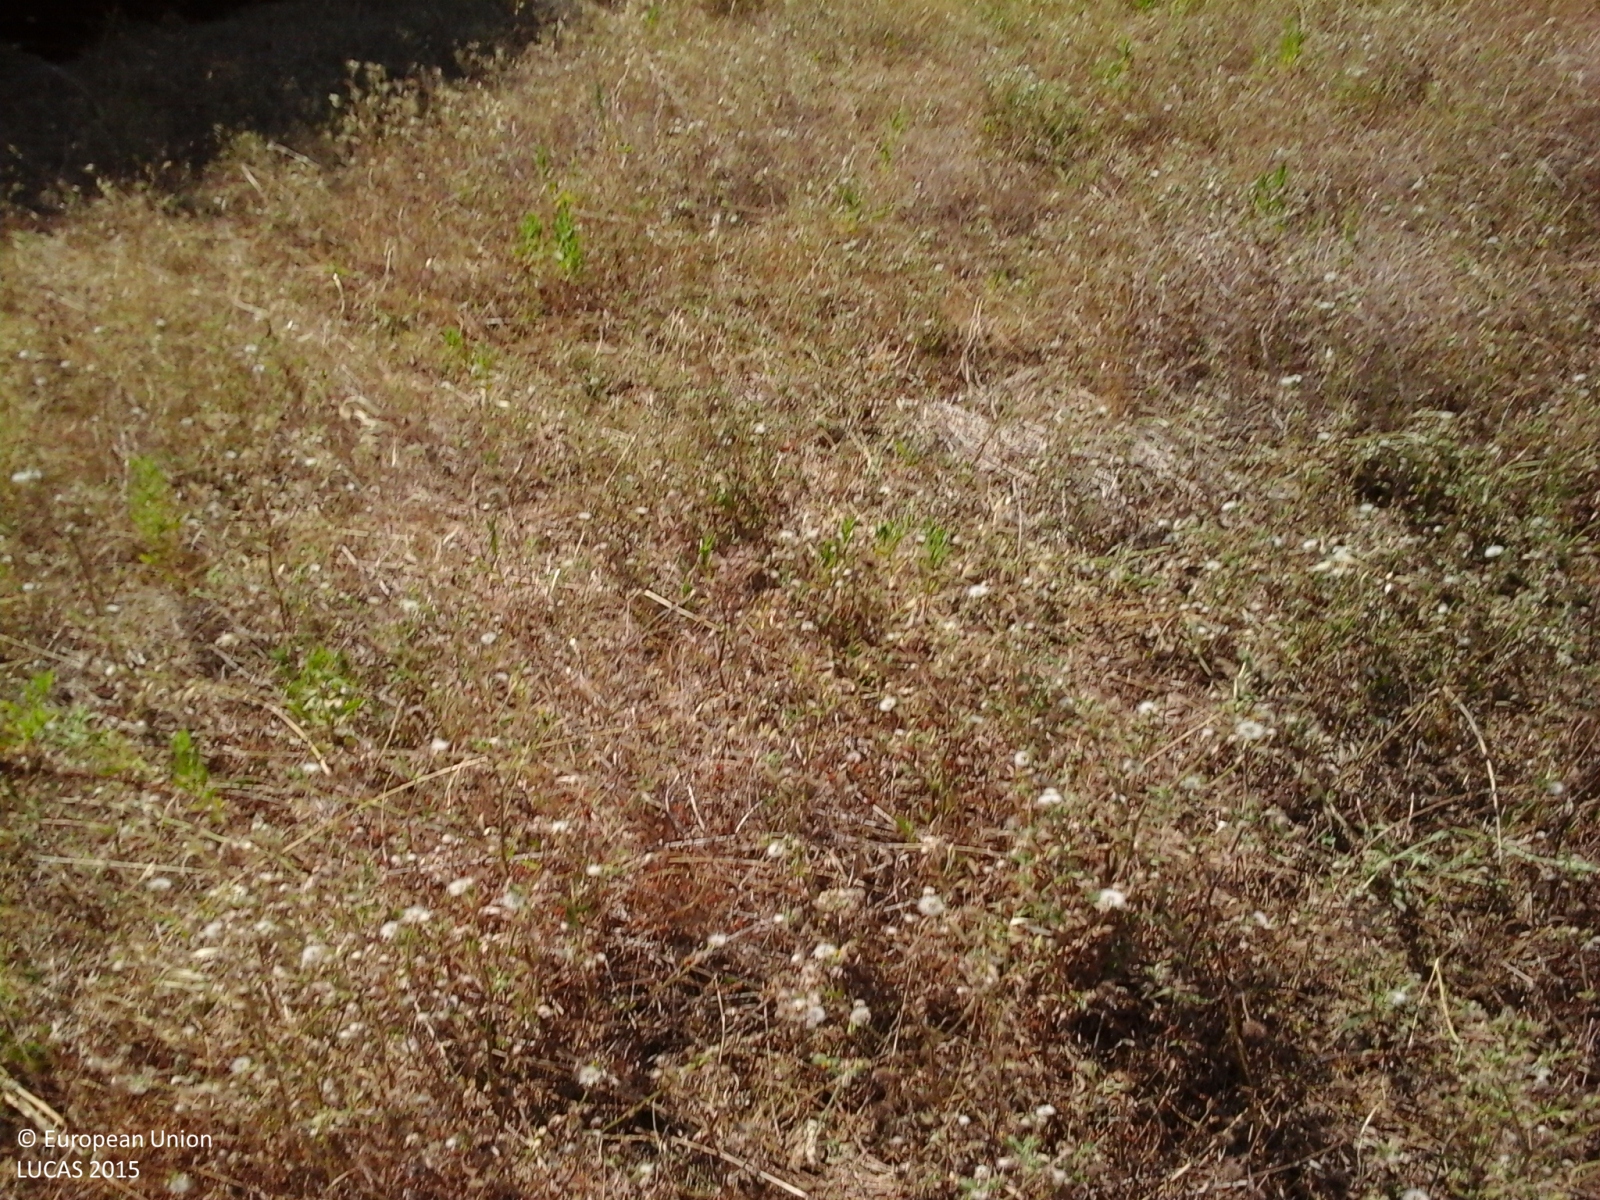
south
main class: Grassland
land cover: Grassland without tree/shrub cover
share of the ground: 50 - 75 %
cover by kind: herbaceous plants 95 %, unconsolidated bare surface 5 %
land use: Agriculture (excluding fallow land and kitchen gardens)
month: July
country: IT
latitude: 42.9849
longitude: 11.5771
